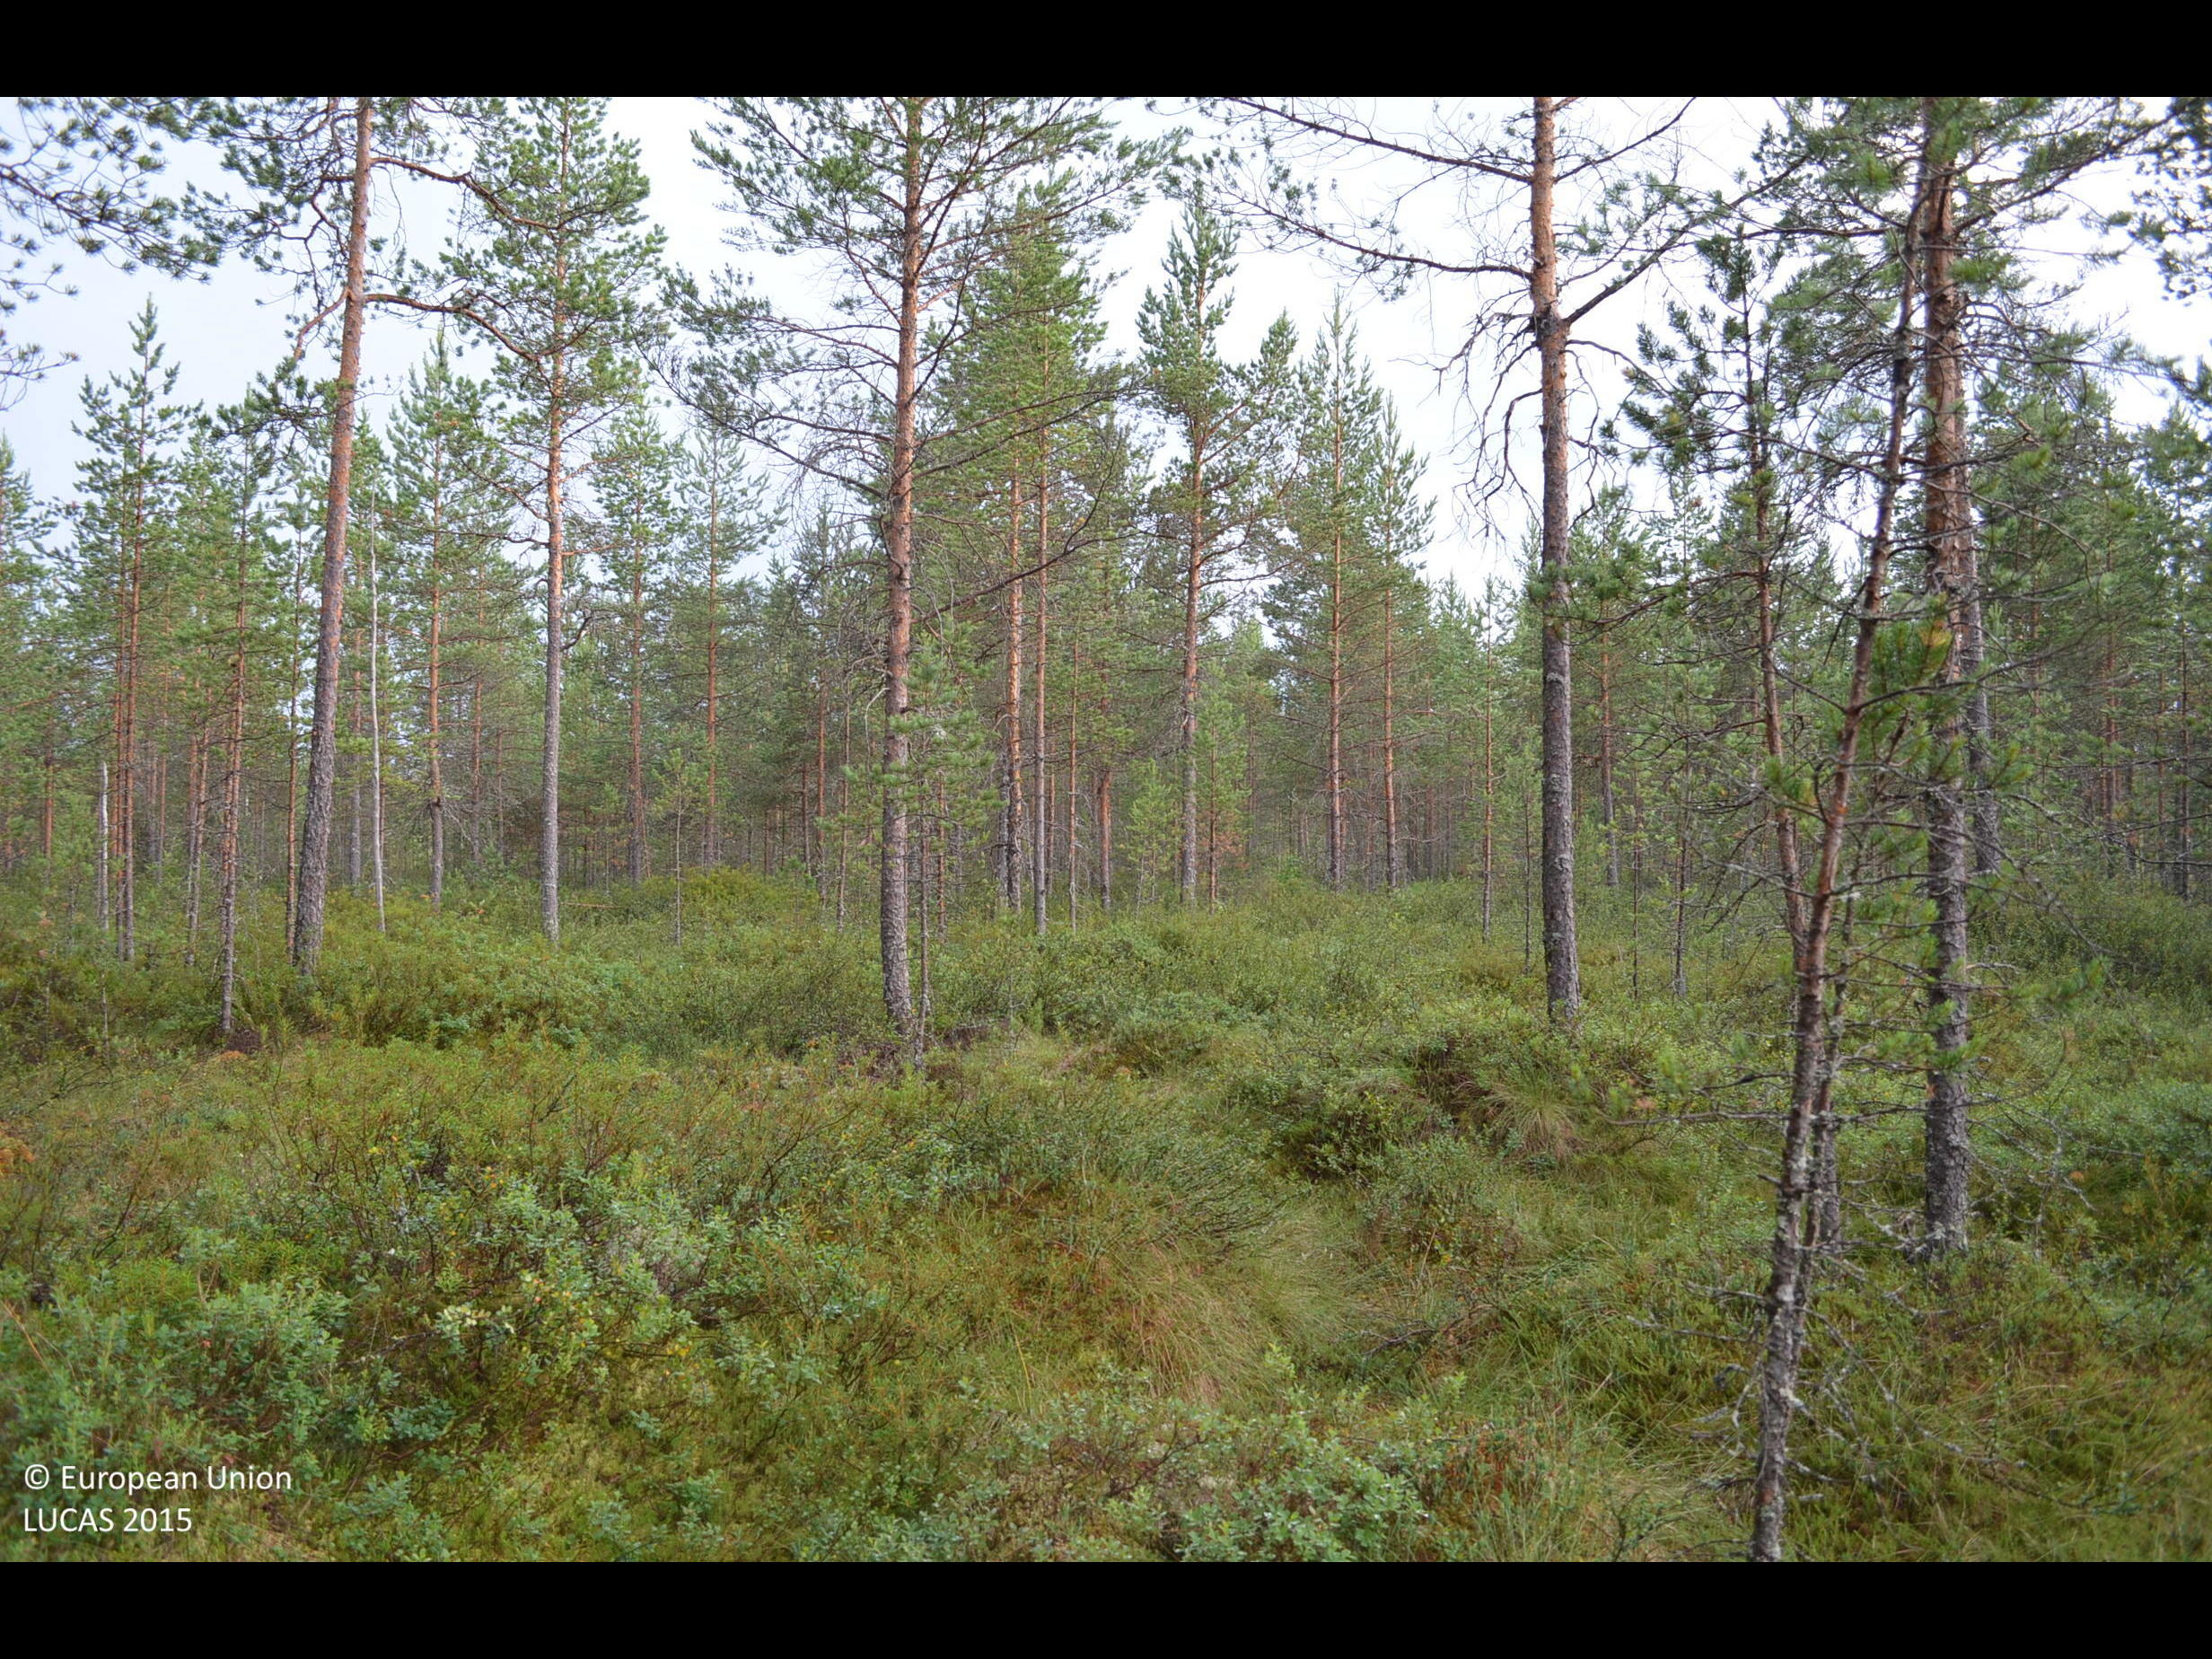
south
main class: Woodland
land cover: Pine dominated coniferous woodland
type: boreal forest
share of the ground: 50 - 75 %
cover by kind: coniferous forest trees 55 %, shrubs 35 %, broadleaved forest trees 5 %, unconsolidated bare surface 5 %
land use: Forestry
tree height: > 5 m
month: July
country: FI
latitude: 62.2296
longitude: 23.4042
